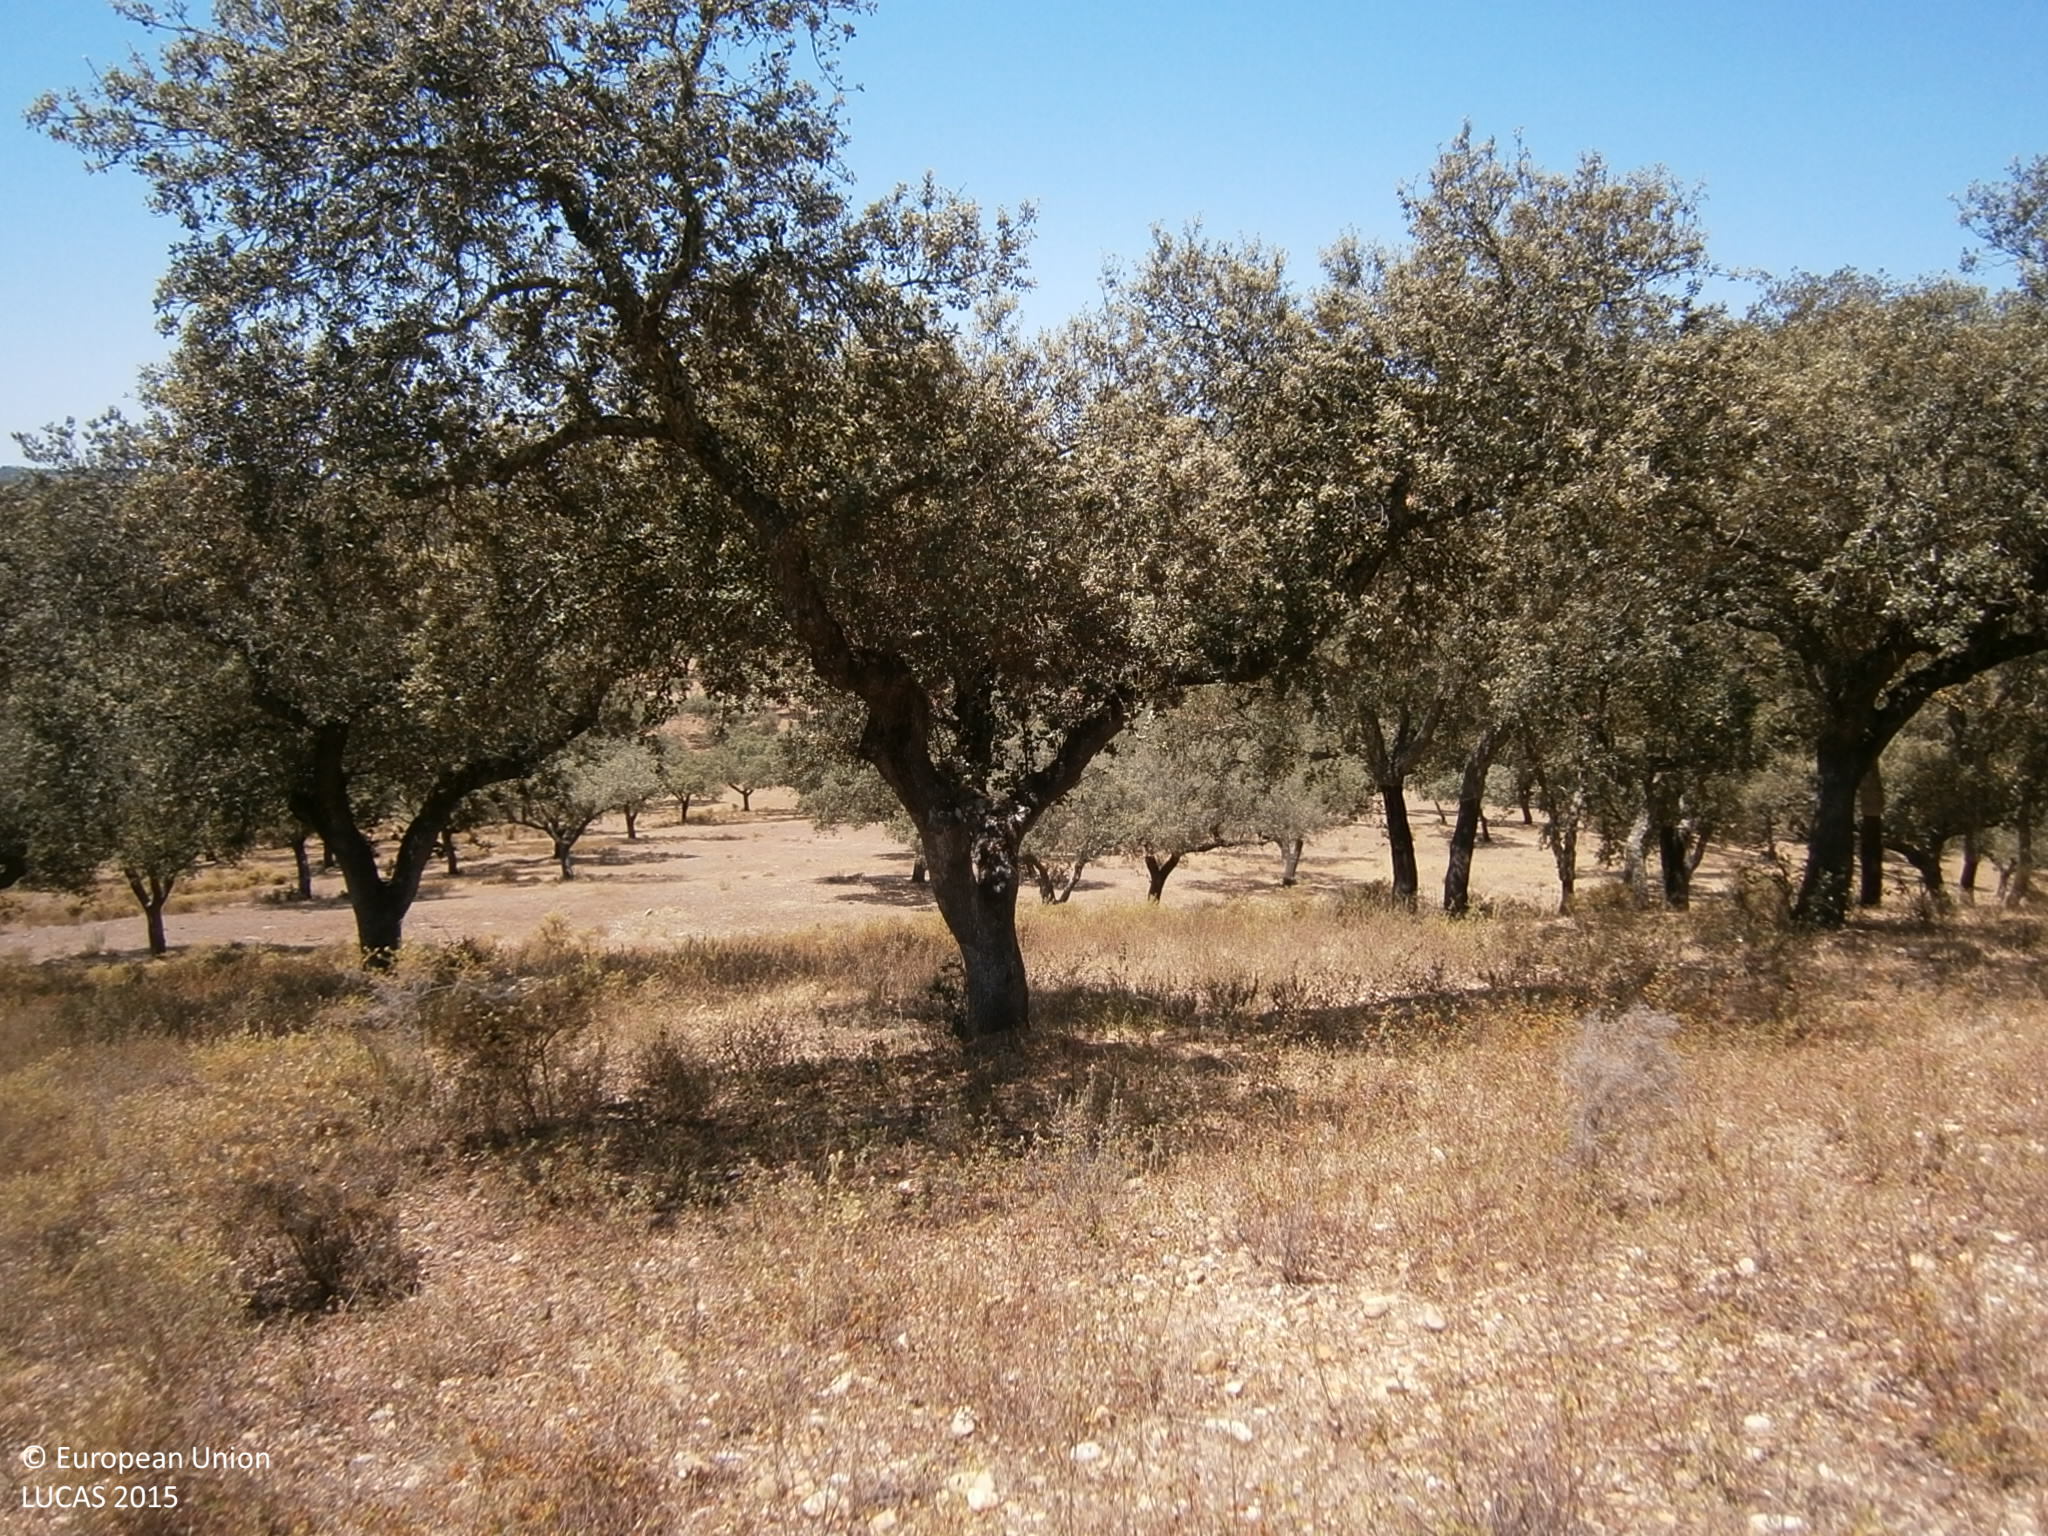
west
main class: Woodland
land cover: Broadleaved woodland
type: broadleaved evergreen forest
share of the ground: 25 - 50 %
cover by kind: shrubs 55 %, broadleaved forest trees 45 %
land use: Forestry
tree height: > 5 m
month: July
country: ES
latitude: 38.6348
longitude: -7.2456
